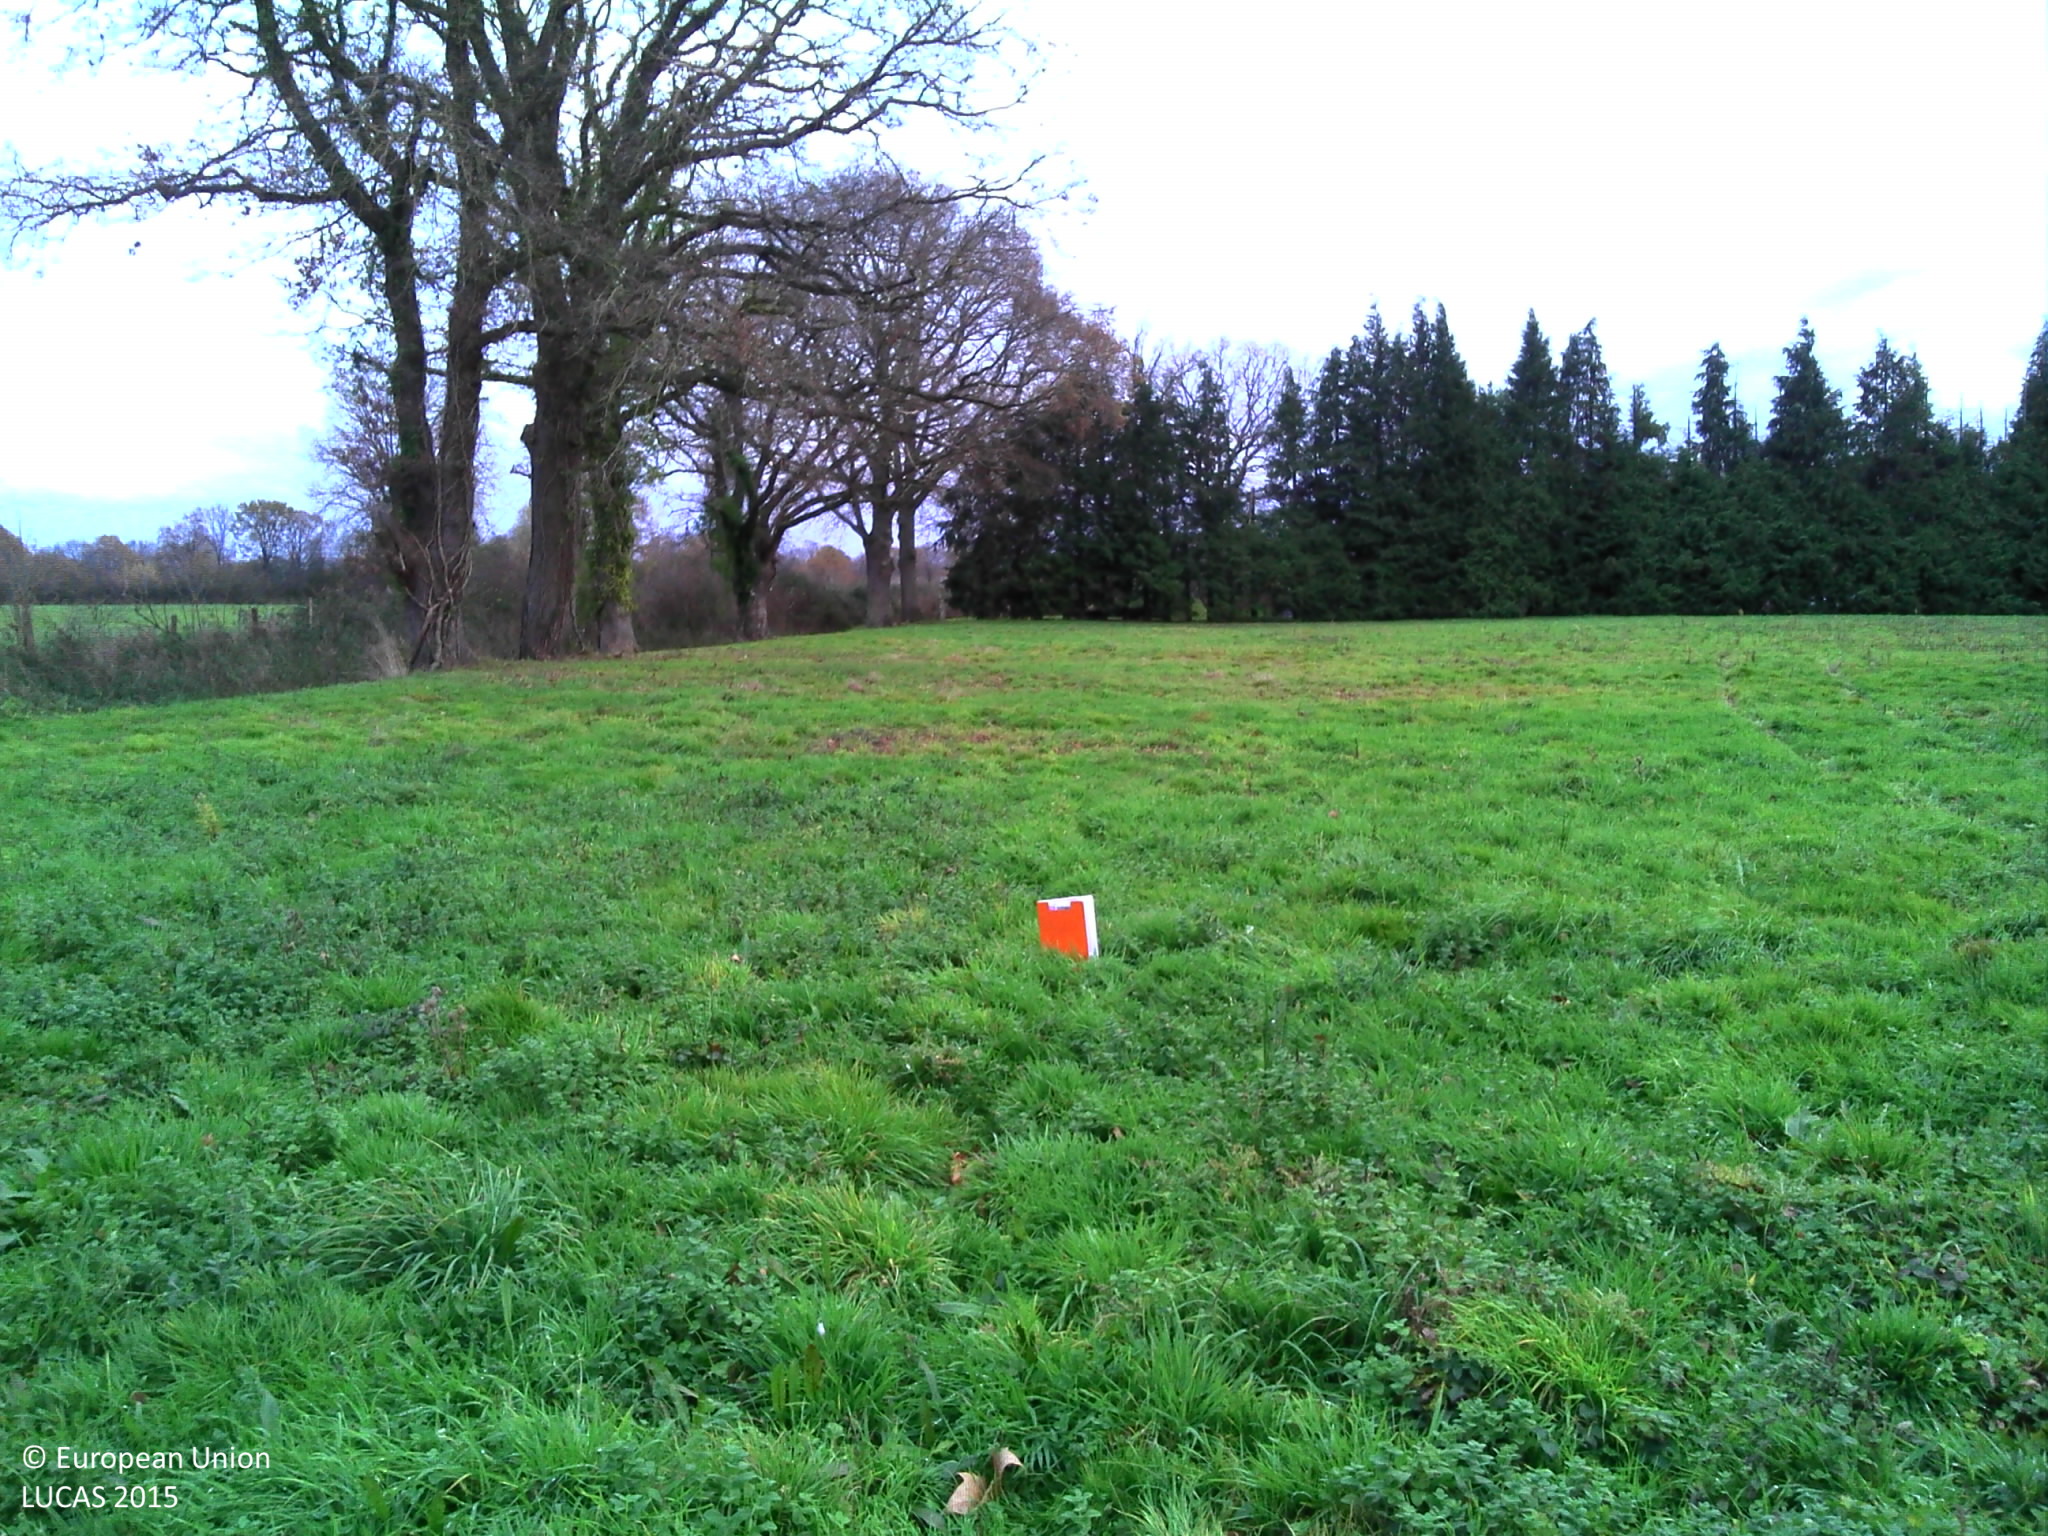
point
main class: Grassland
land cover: Grassland without tree/shrub cover
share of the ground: > 75 %
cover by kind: herbaceous plants 100 %
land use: Agriculture (excluding fallow land and kitchen gardens)
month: November
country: FR
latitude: 46.6108
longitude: 3.2998
